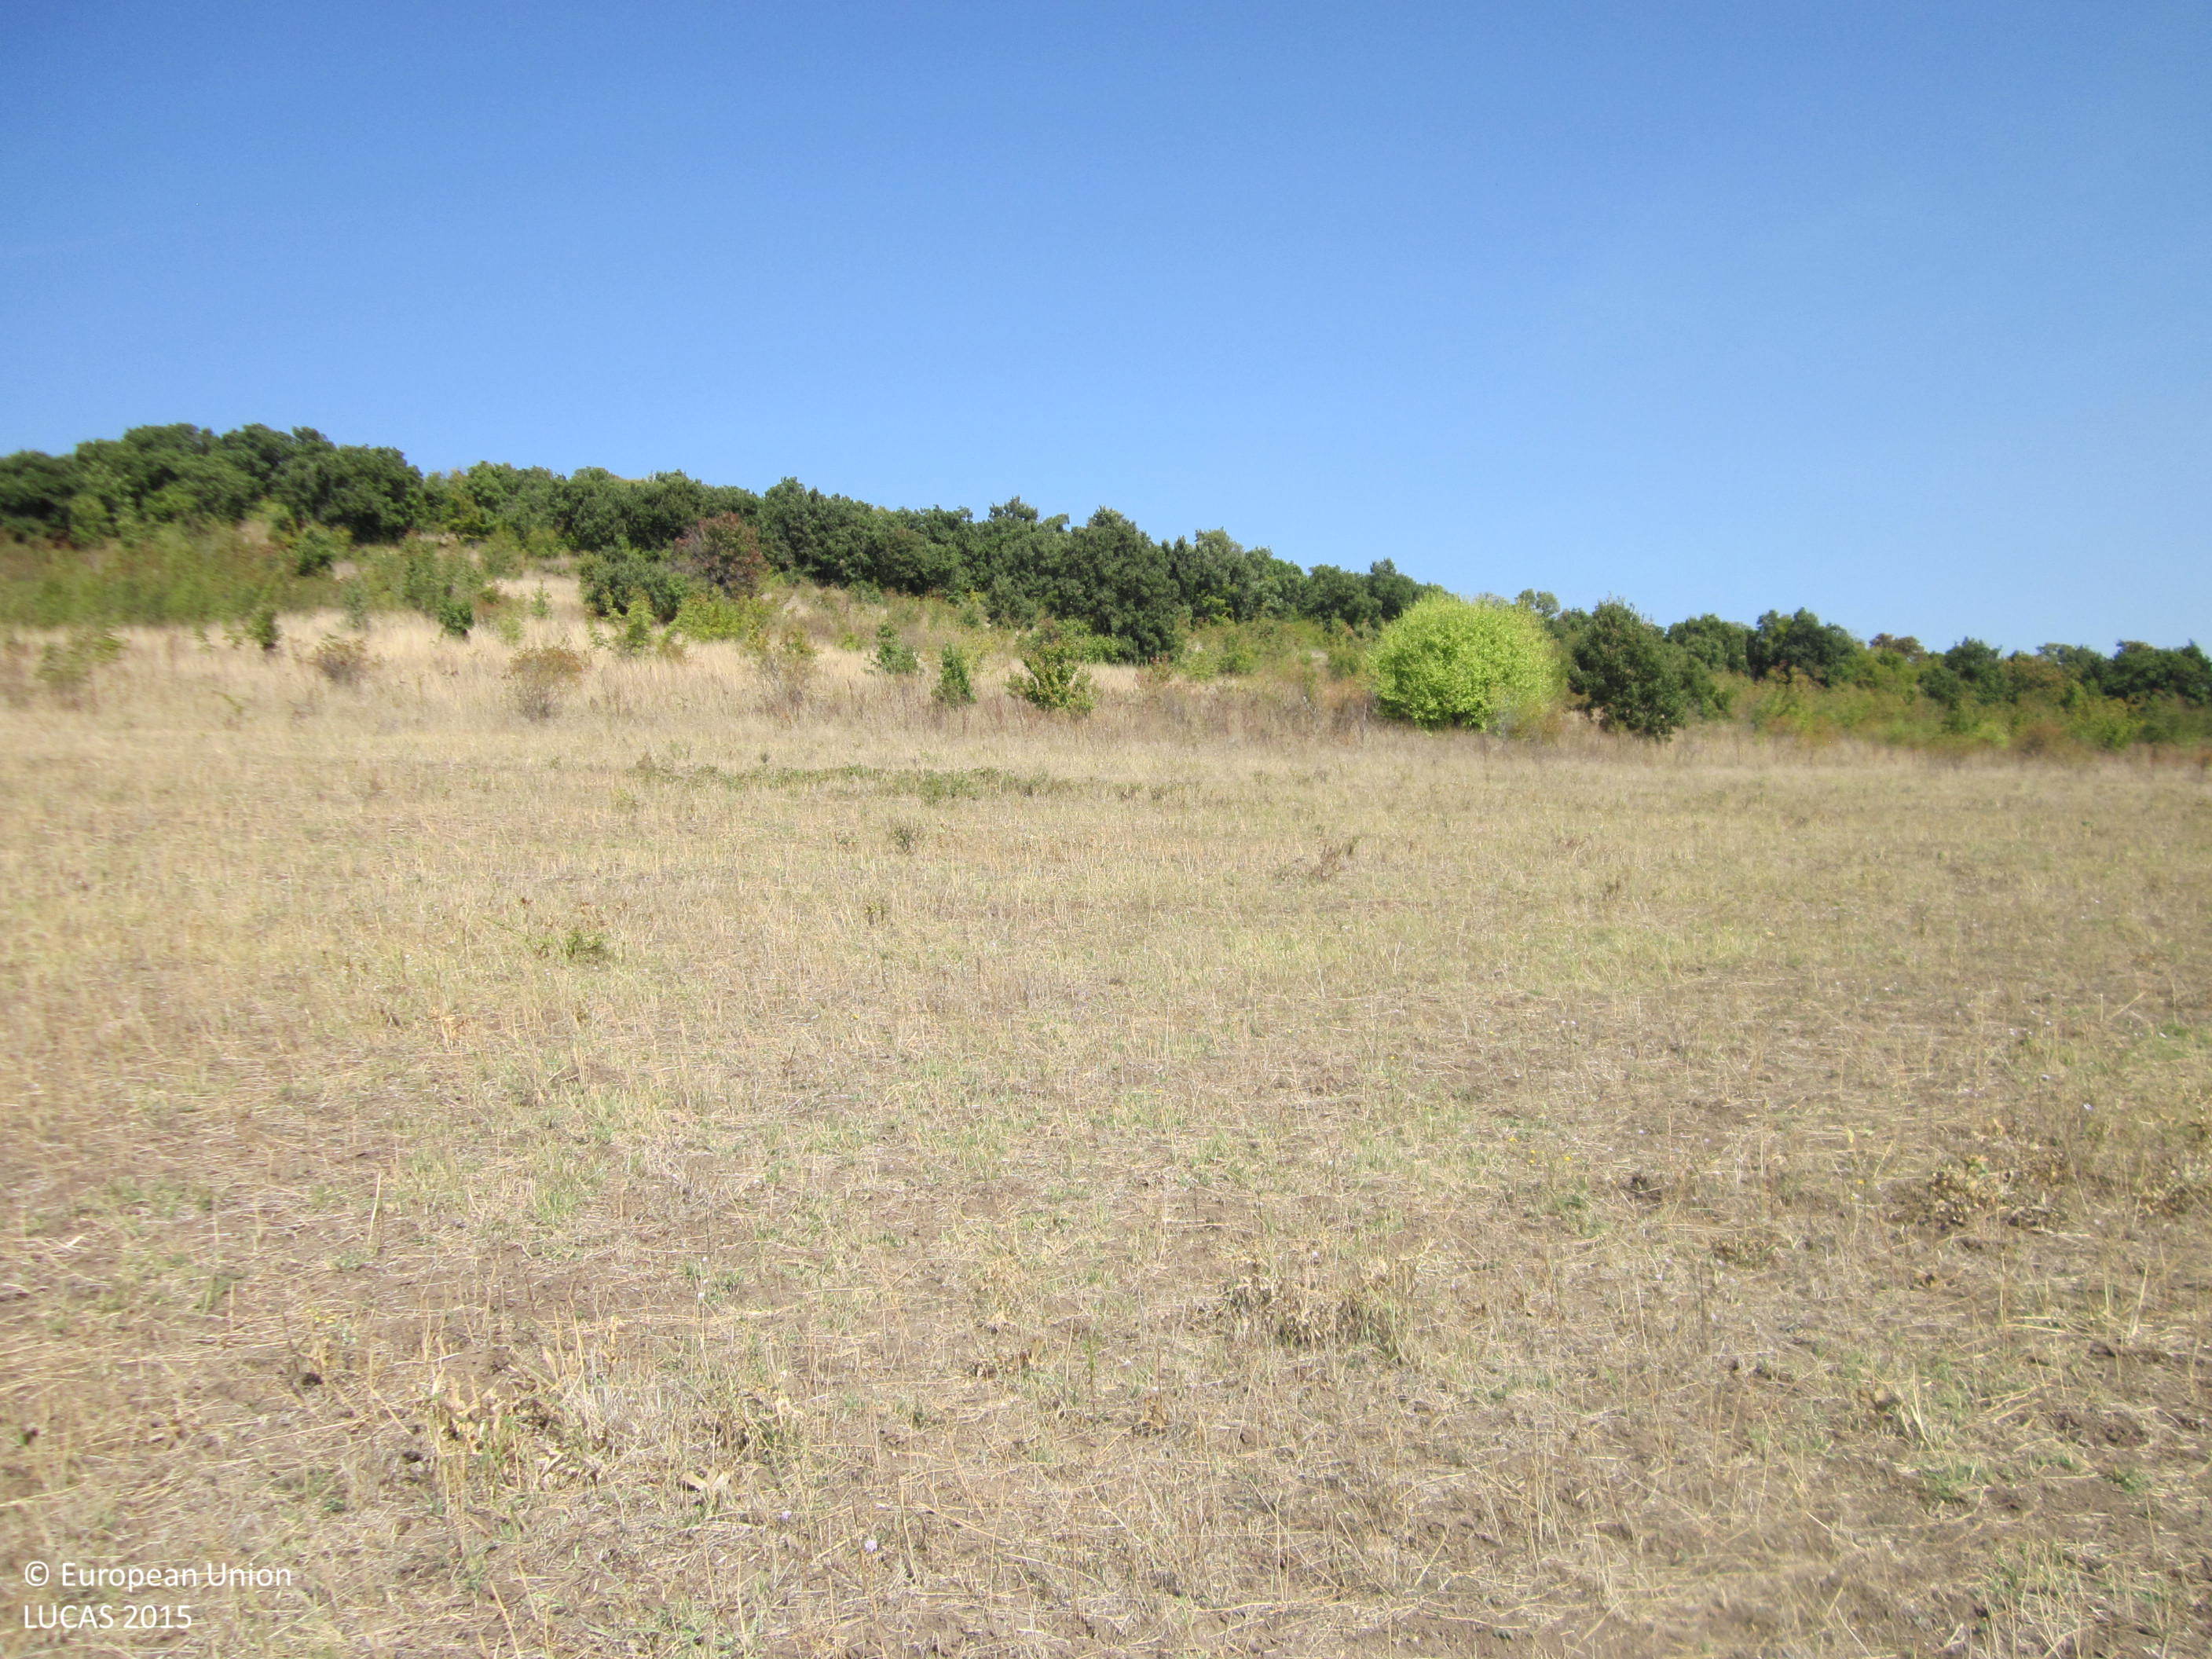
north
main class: Grassland
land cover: Grassland without tree/shrub cover
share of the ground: > 75 %
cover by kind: herbaceous plants 80 %, unconsolidated bare surface 20 %
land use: Agriculture (excluding fallow land and kitchen gardens)
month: September
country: BG
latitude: 42.6372
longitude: 27.4477
